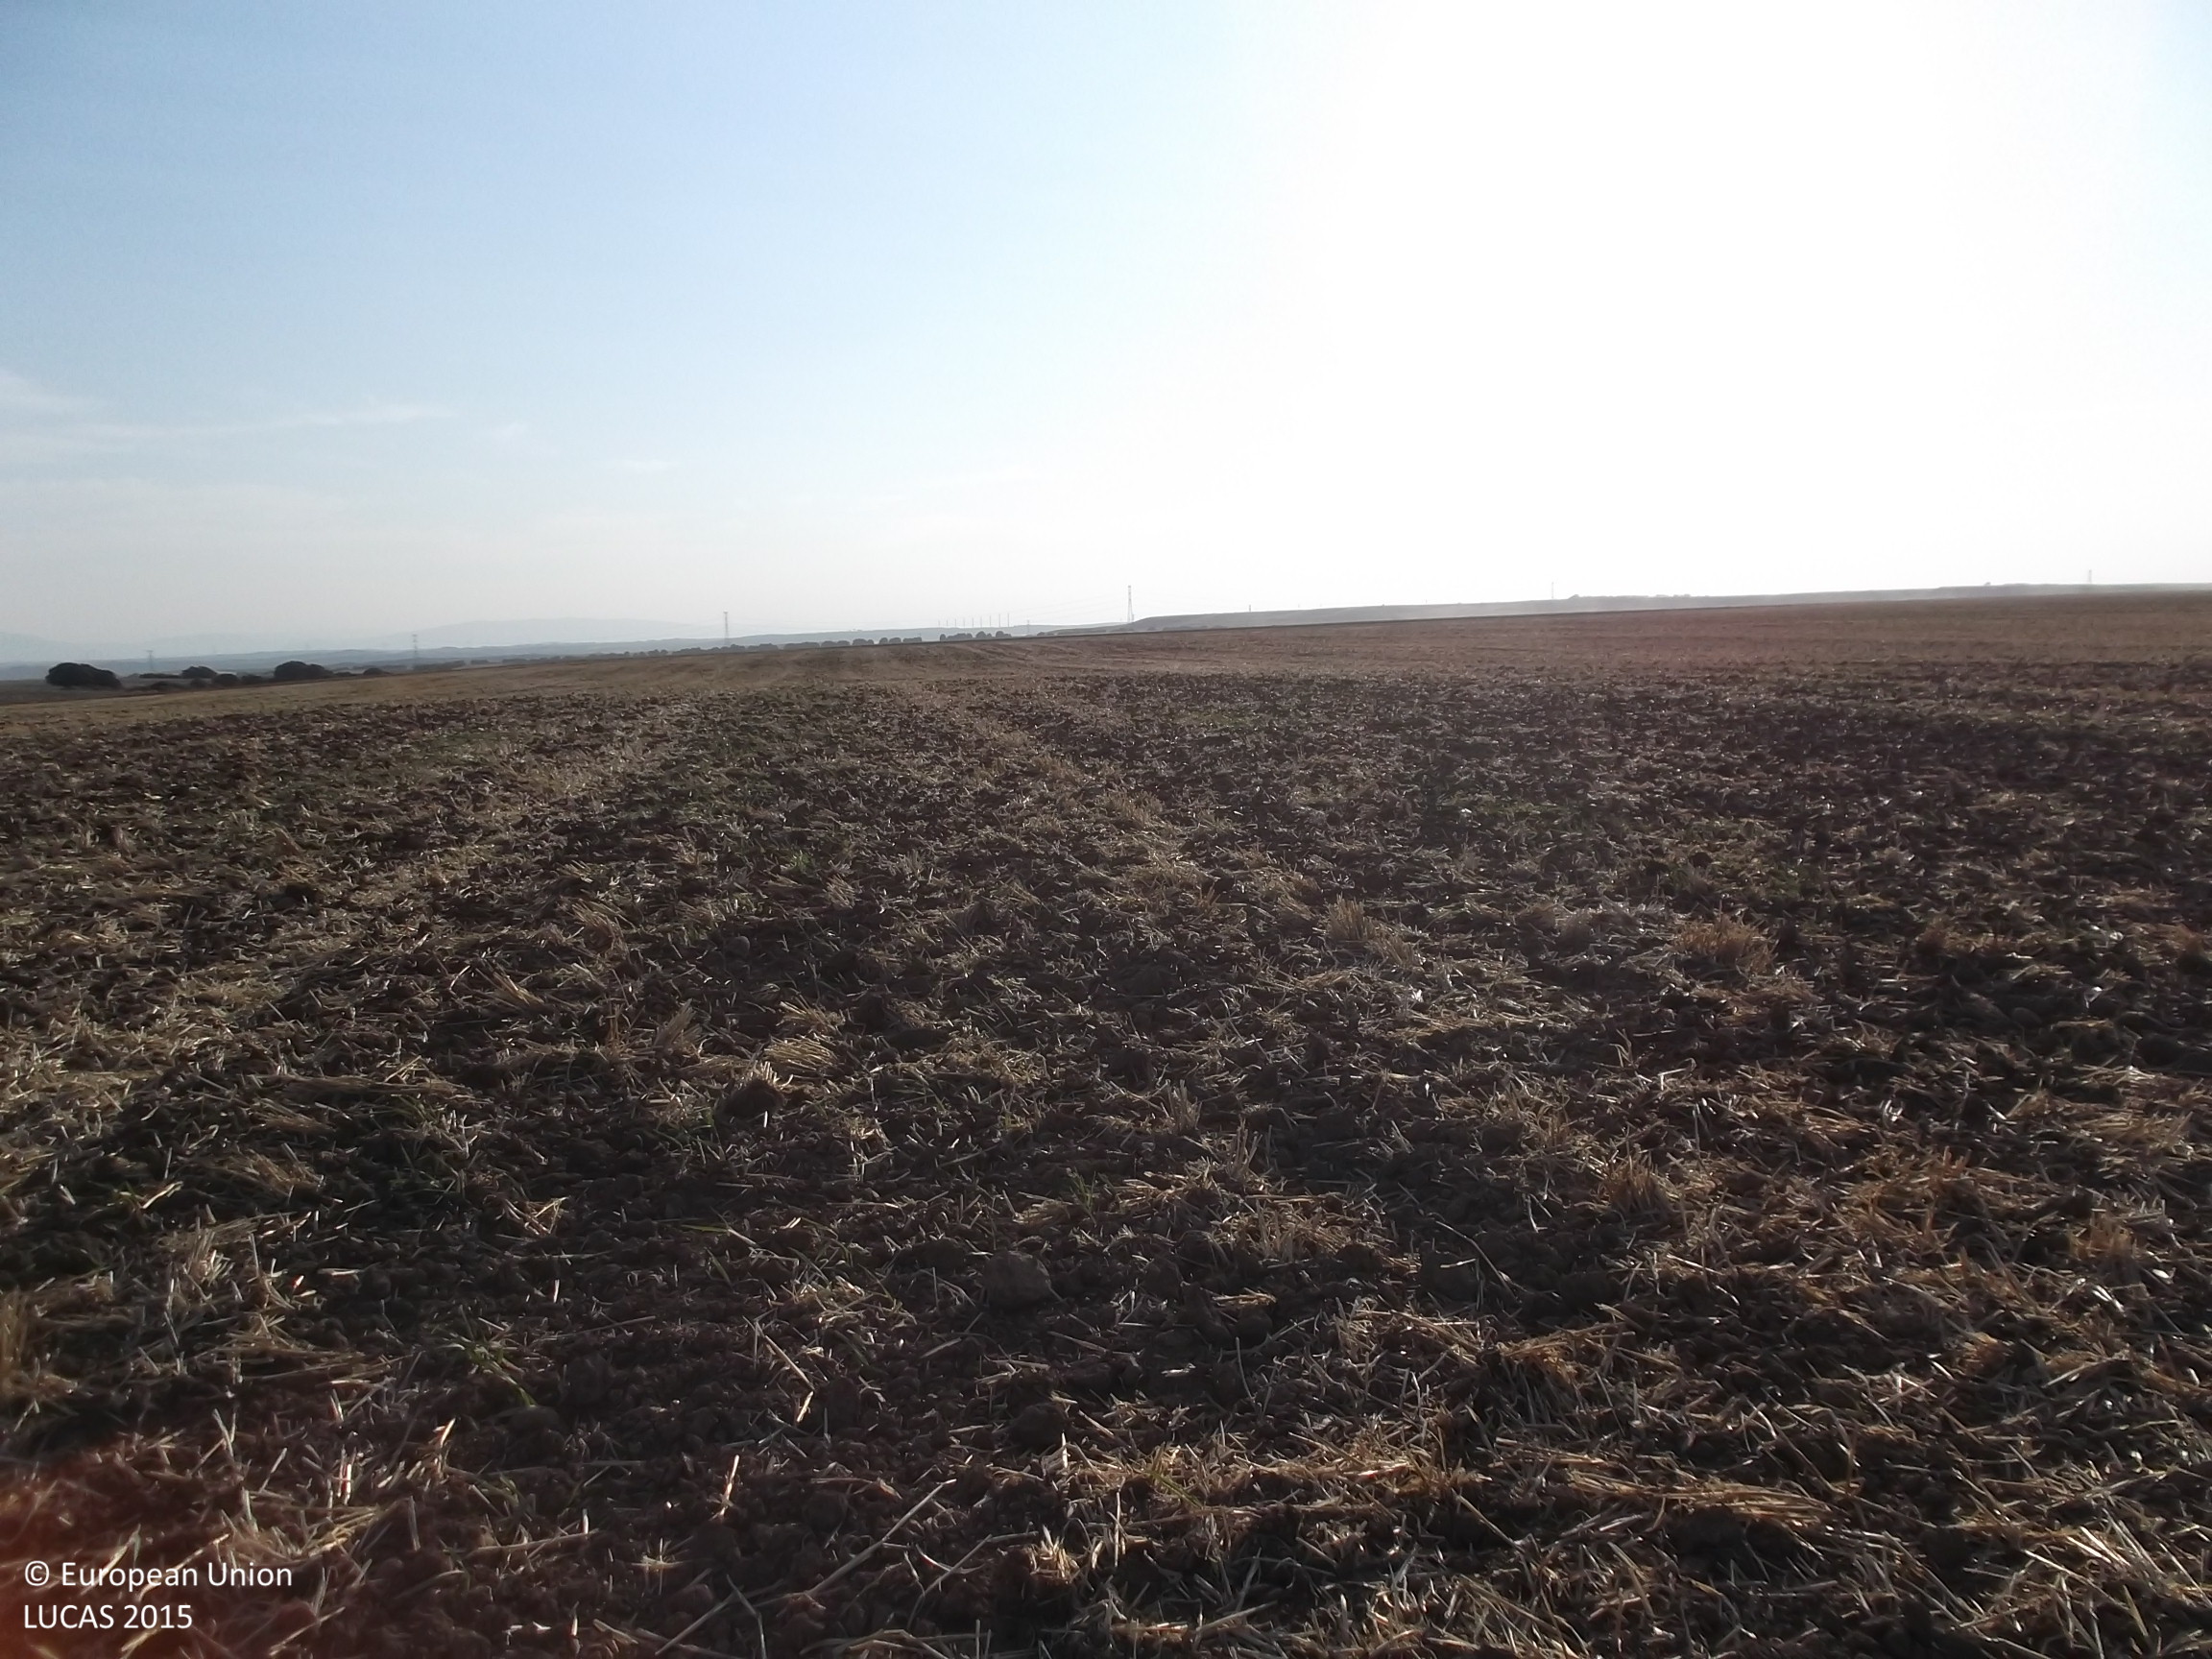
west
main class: Cropland
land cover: Barley
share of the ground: < 10 %
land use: Agriculture (excluding fallow land and kitchen gardens)
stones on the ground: < 10 %
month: July
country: ES
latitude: 42.3944
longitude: -1.6858
